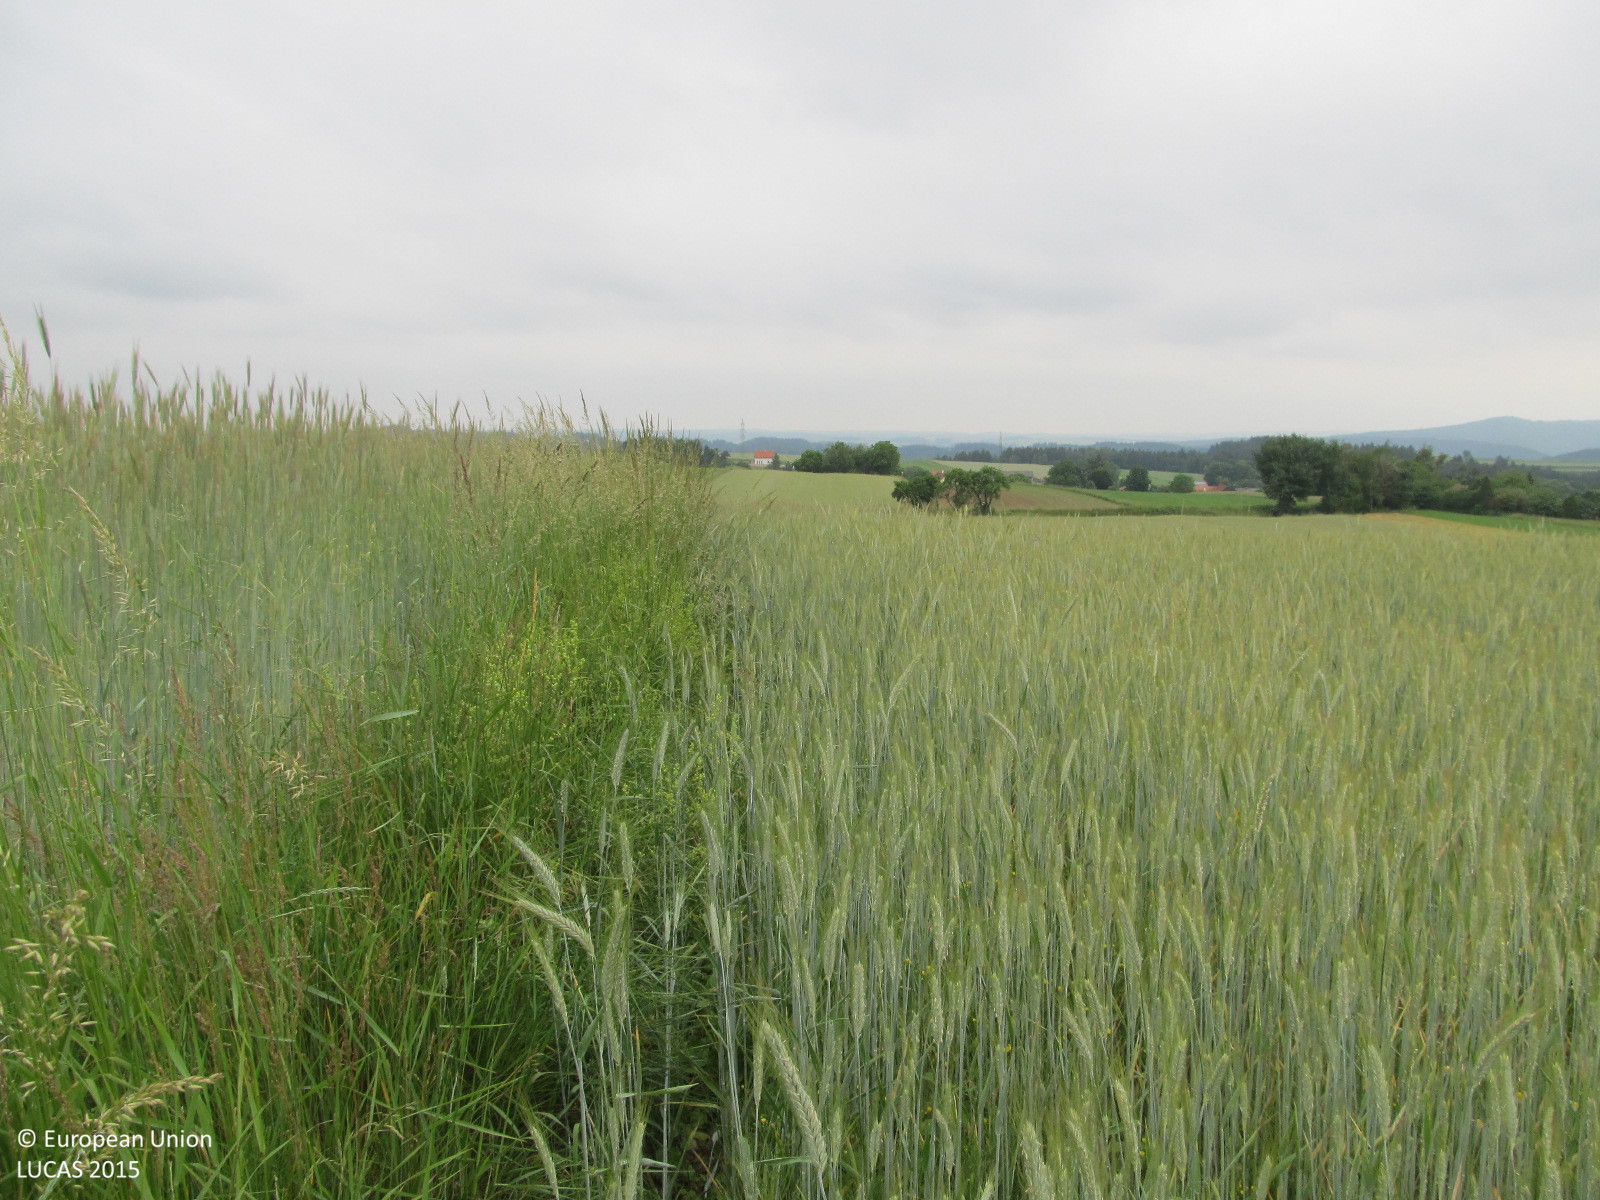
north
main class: Cropland
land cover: Rye
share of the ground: > 75 %
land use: Agriculture (excluding fallow land and kitchen gardens)
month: June
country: AT
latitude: 48.5749
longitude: 15.4649
